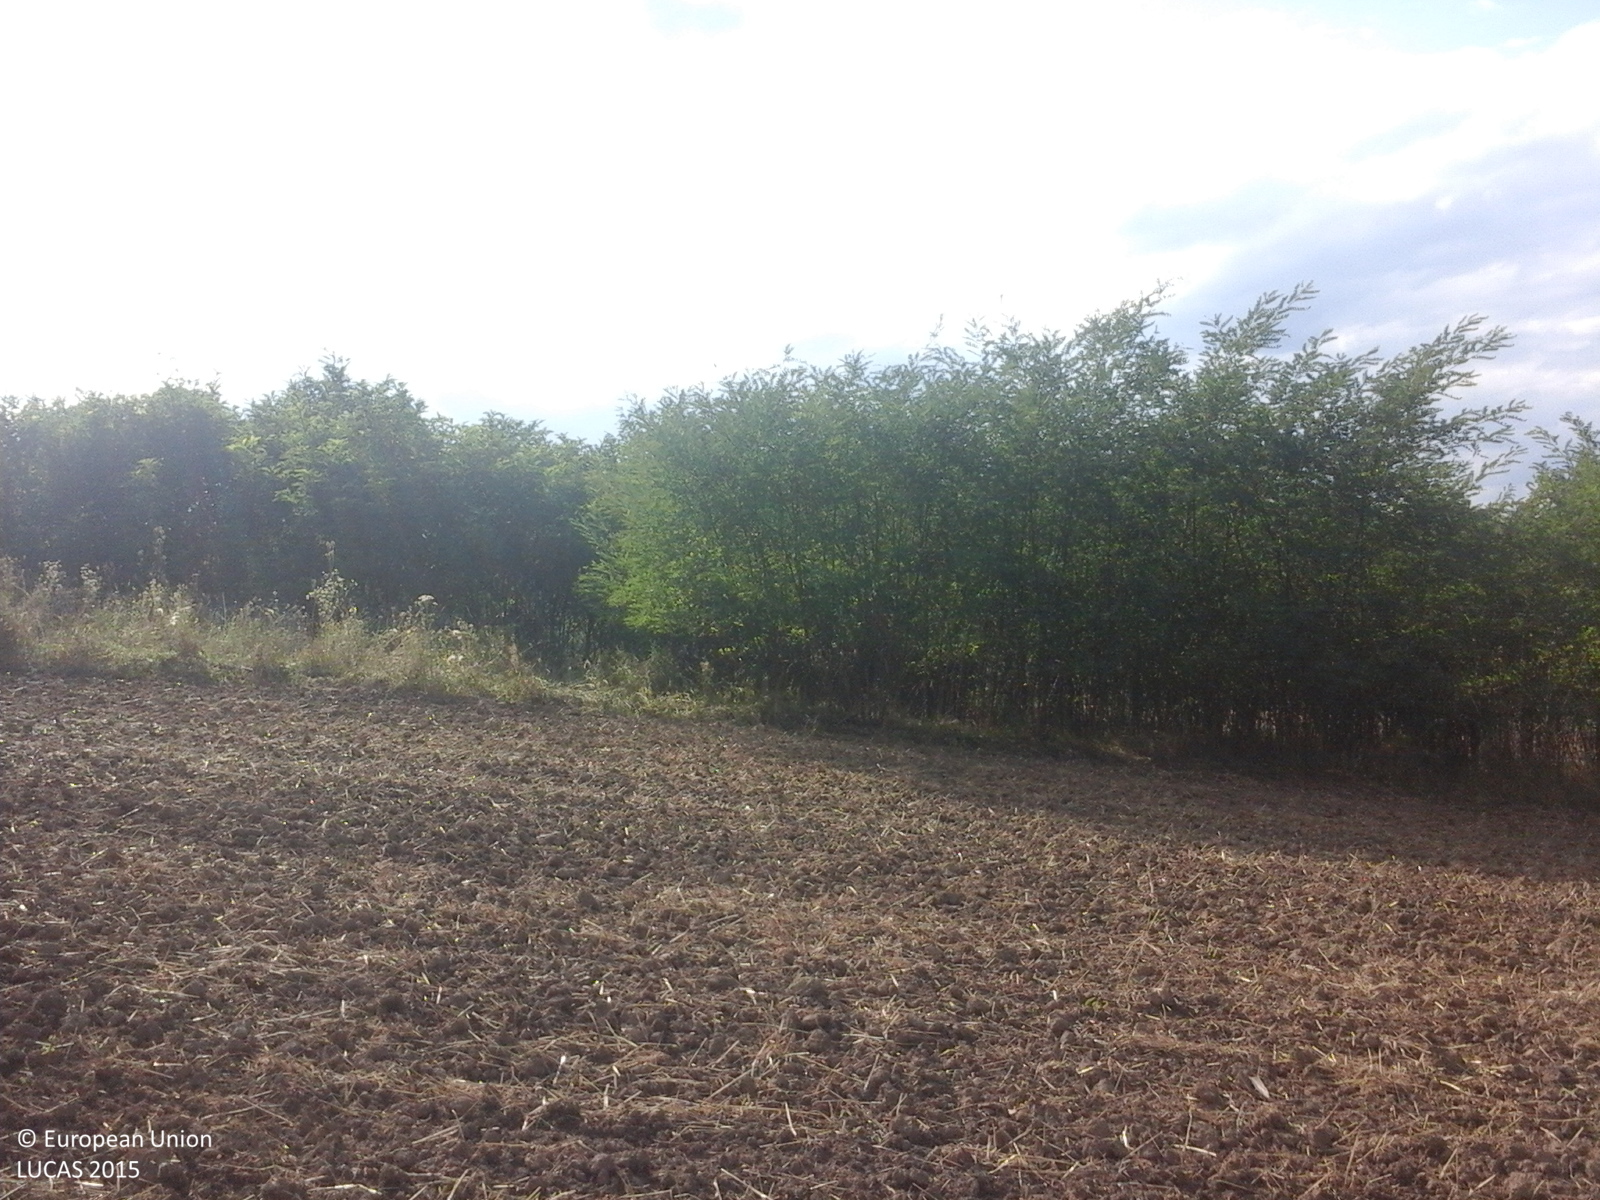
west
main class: Cropland
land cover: Common wheat
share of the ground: 10 - 25 %
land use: Agriculture (excluding fallow land and kitchen gardens)
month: September
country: RO
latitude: 47.4055
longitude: 23.0654
